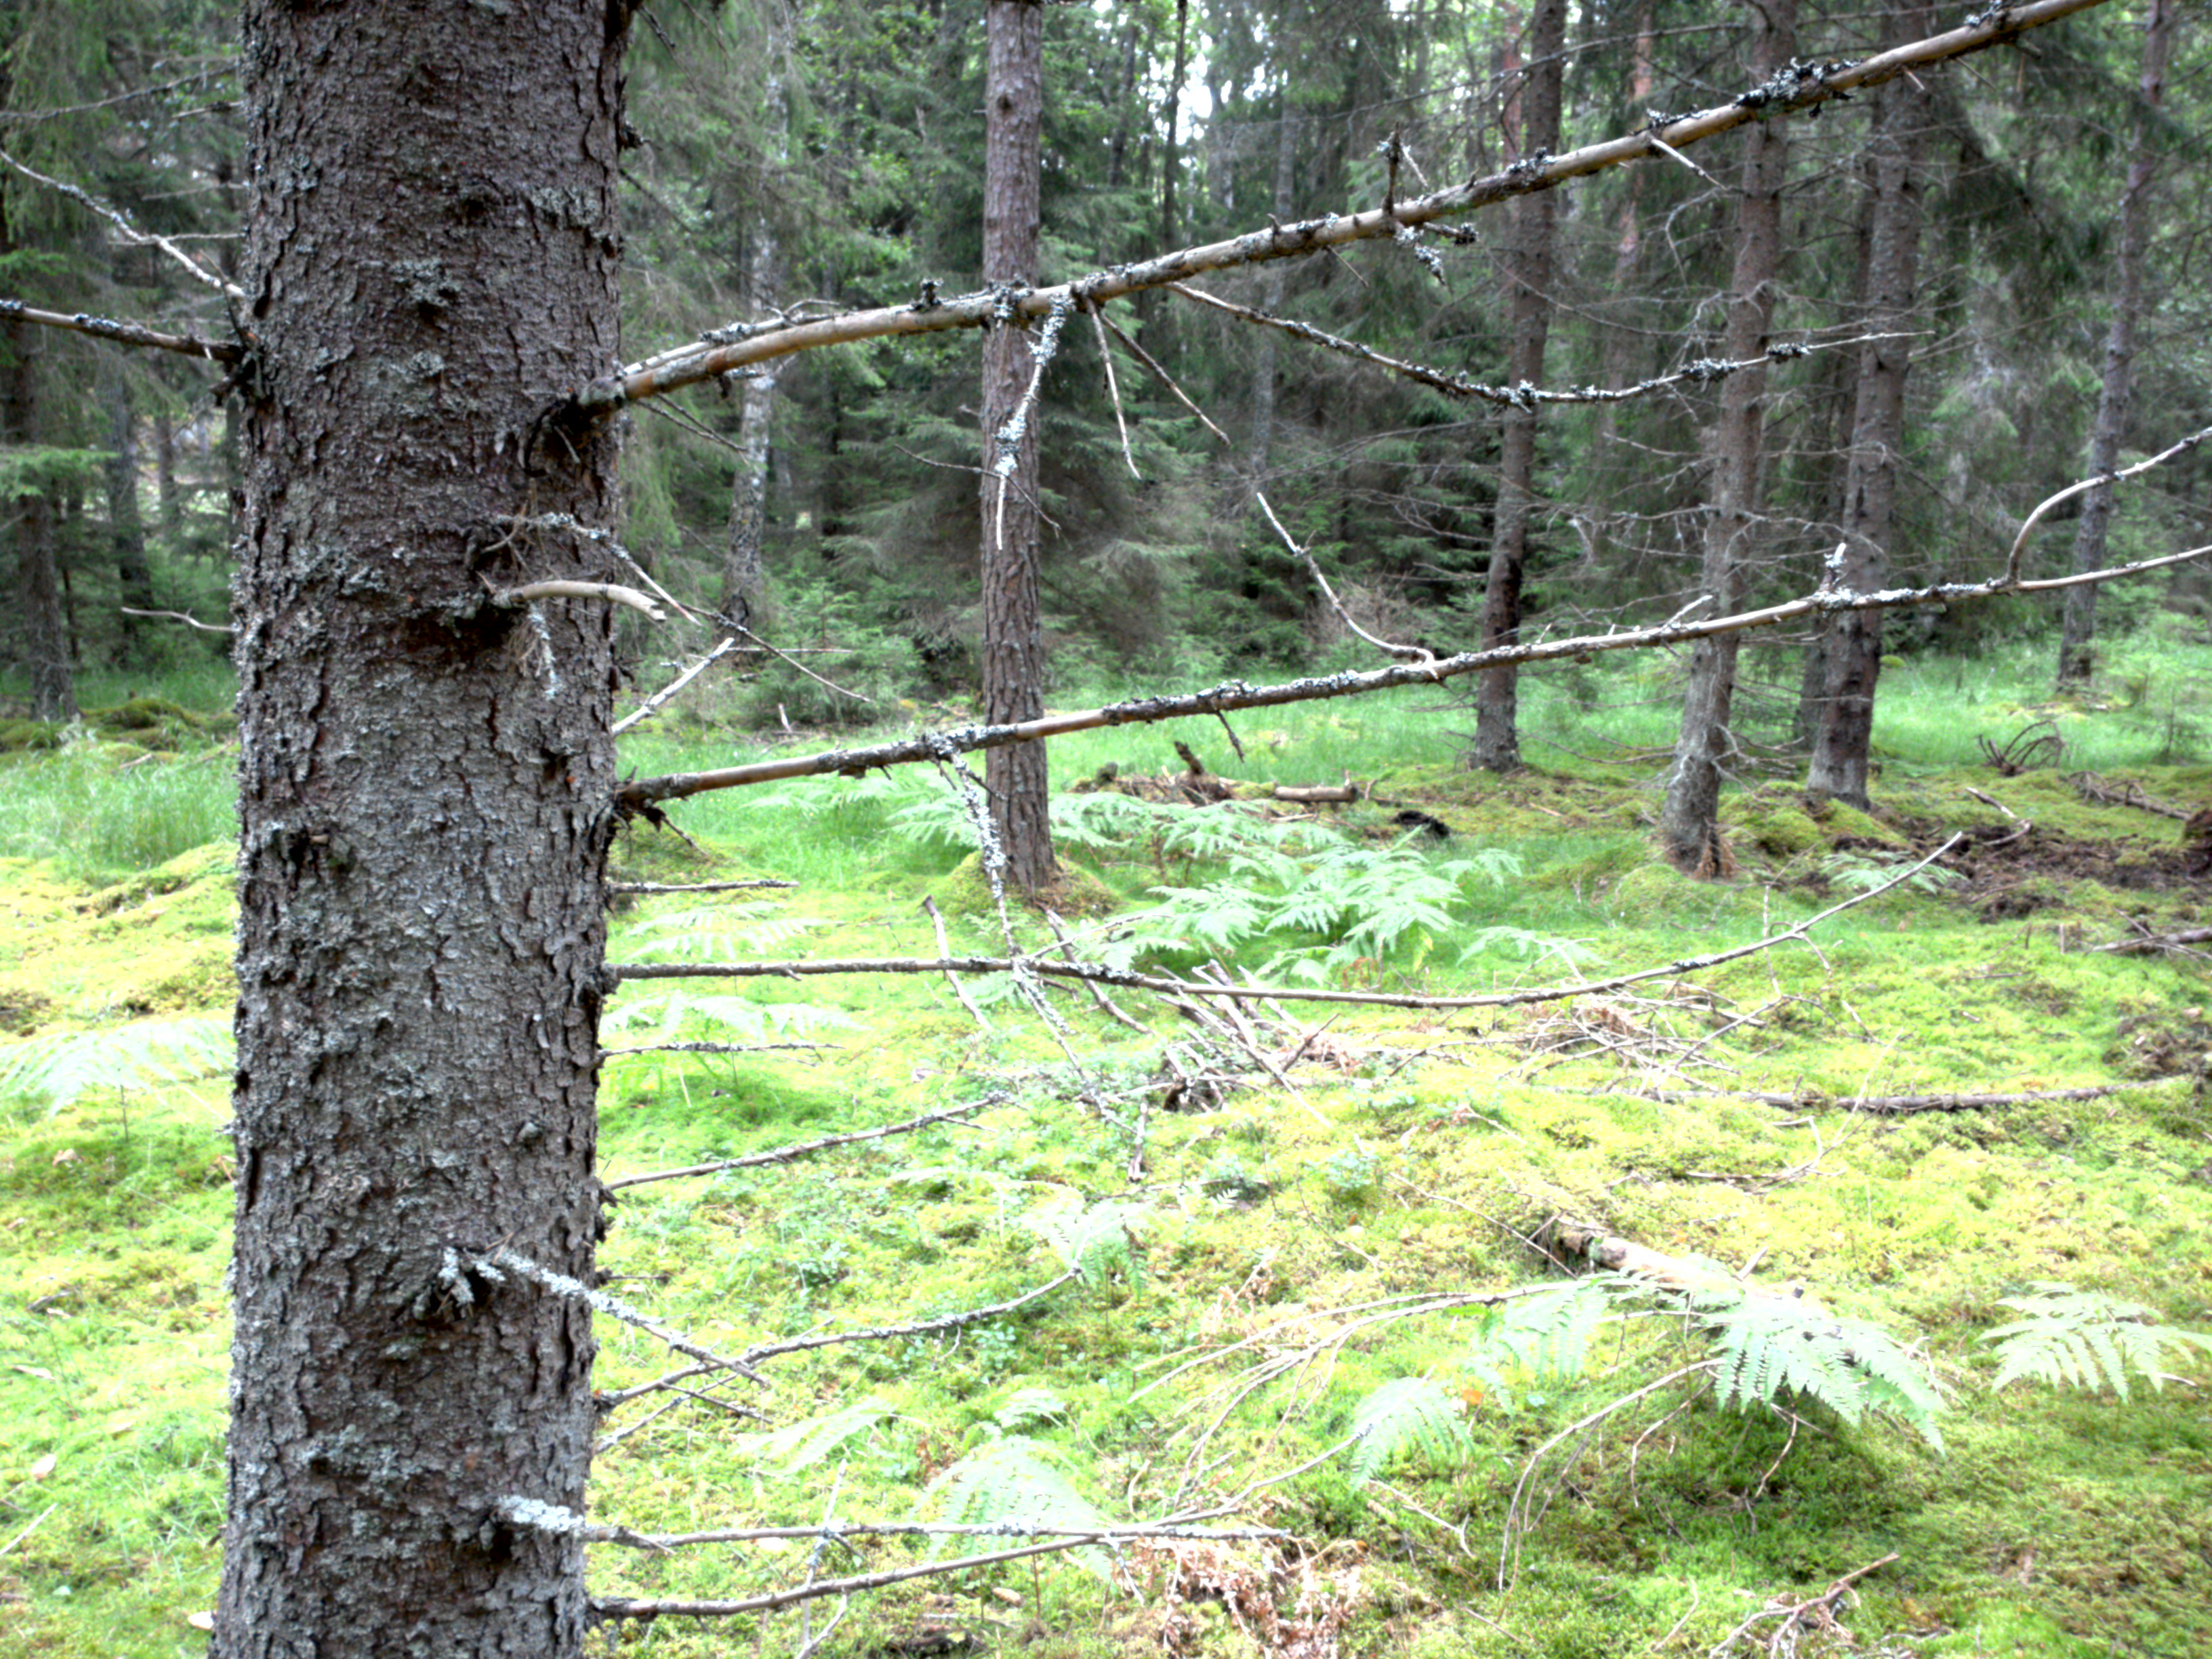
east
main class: Woodland
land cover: Spruce dominated coniferous woodland
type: boreal forest
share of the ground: 50 - 75 %
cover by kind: coniferous forest trees 65 %, lichens and mosses 35 %
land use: Forestry
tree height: > 5 m
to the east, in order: Spruce dominated coniferous woodland; Spruce dominated mixed woodland; Pine dominated coniferous woodland; Ditches and canals; Tracks; Spruce dominated mixed woodland; Ditches and canals; Spruce dominated coniferous woodland
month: July
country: SE
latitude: 59.1232
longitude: 18.2639
